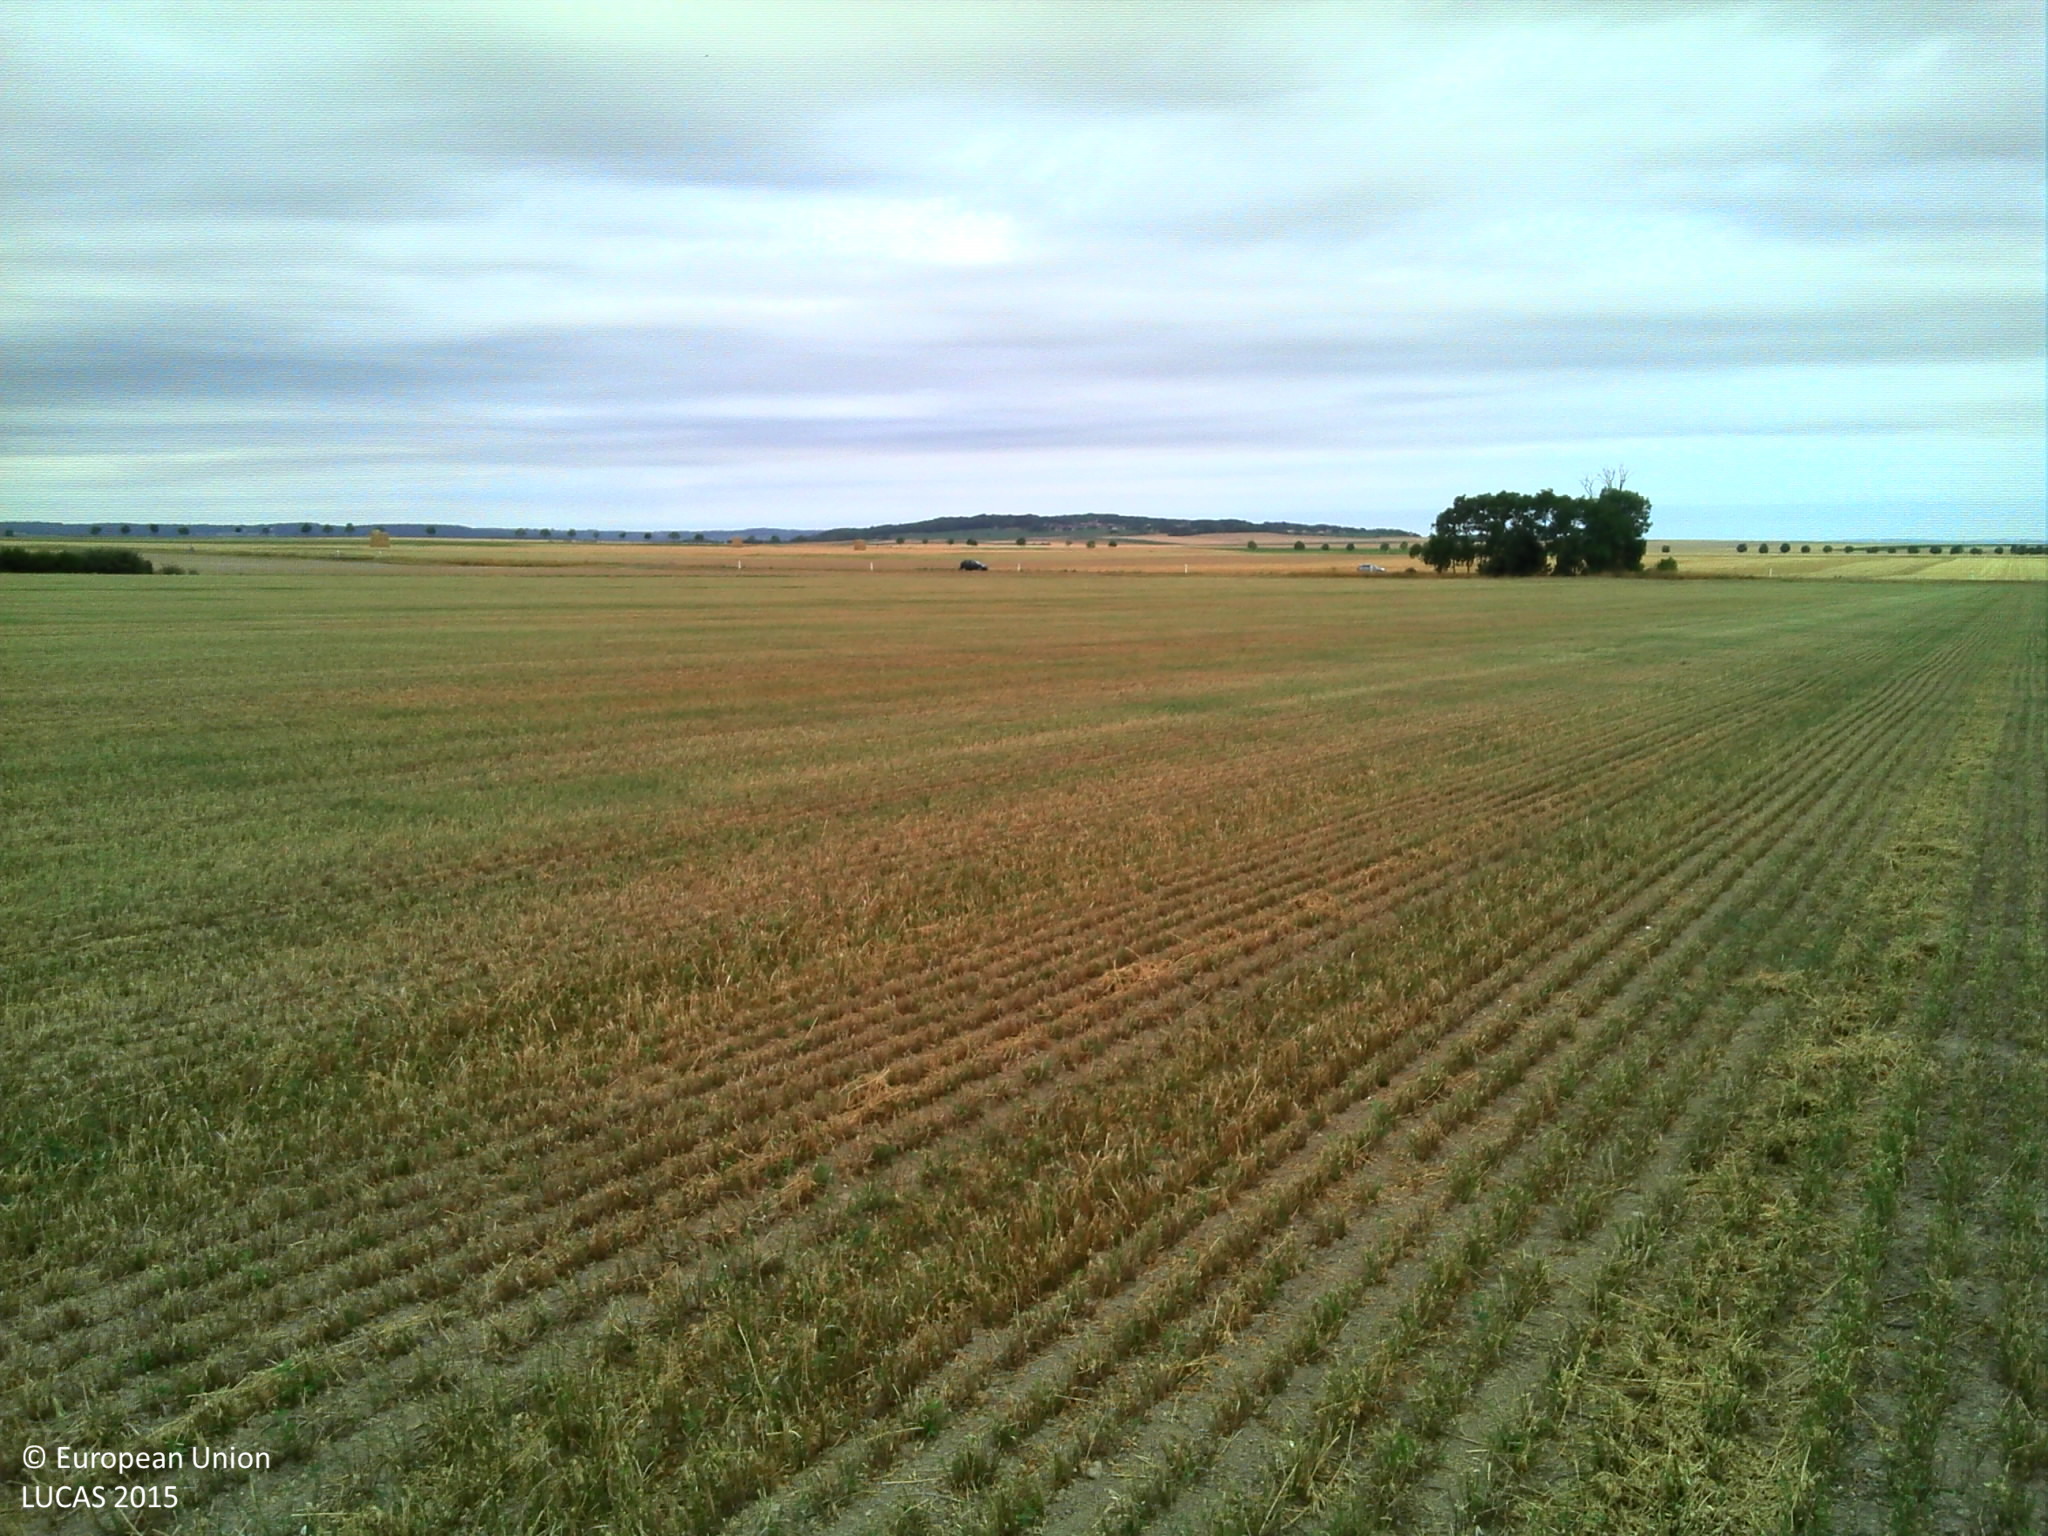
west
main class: Cropland
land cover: Lucerne
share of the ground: > 75 %
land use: Agriculture (excluding fallow land and kitchen gardens)
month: July
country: FR
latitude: 49.3278
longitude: 4.0923
